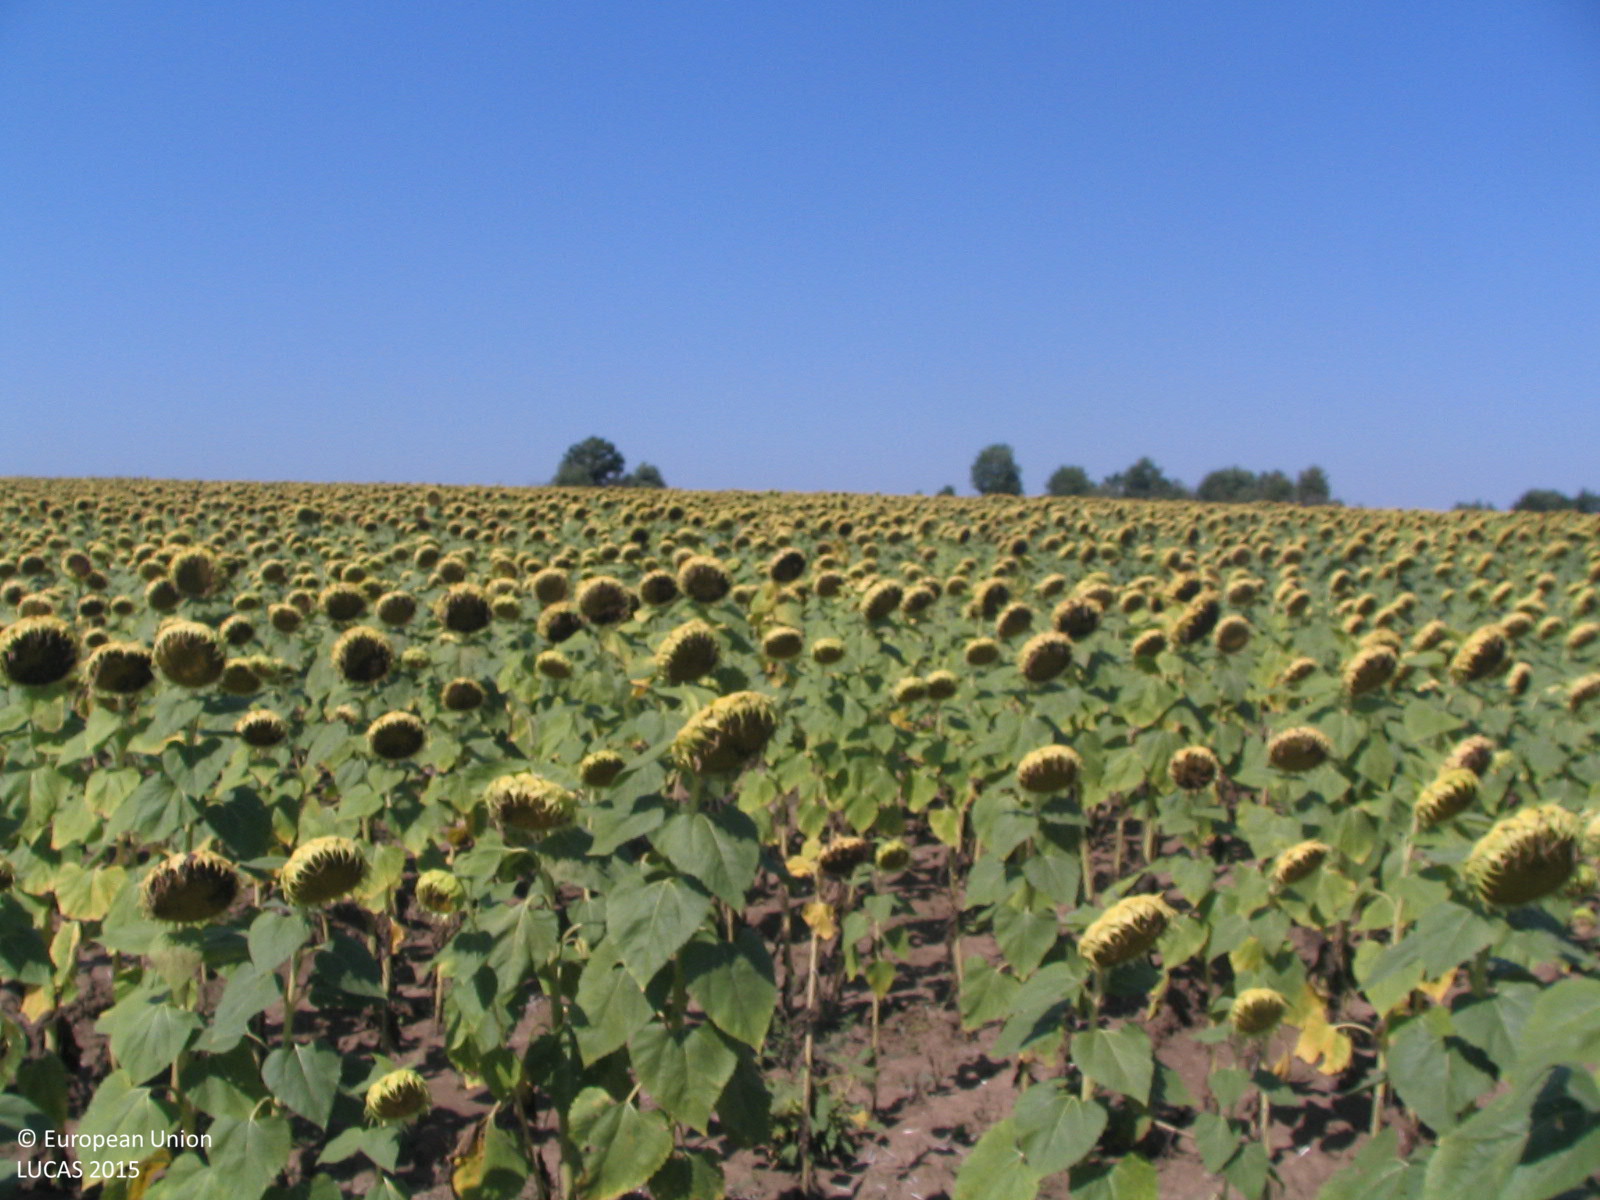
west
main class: Cropland
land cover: Sunflower
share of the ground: > 75 %
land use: Agriculture (excluding fallow land and kitchen gardens)
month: August
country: BG
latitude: 43.1838
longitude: 24.3399
